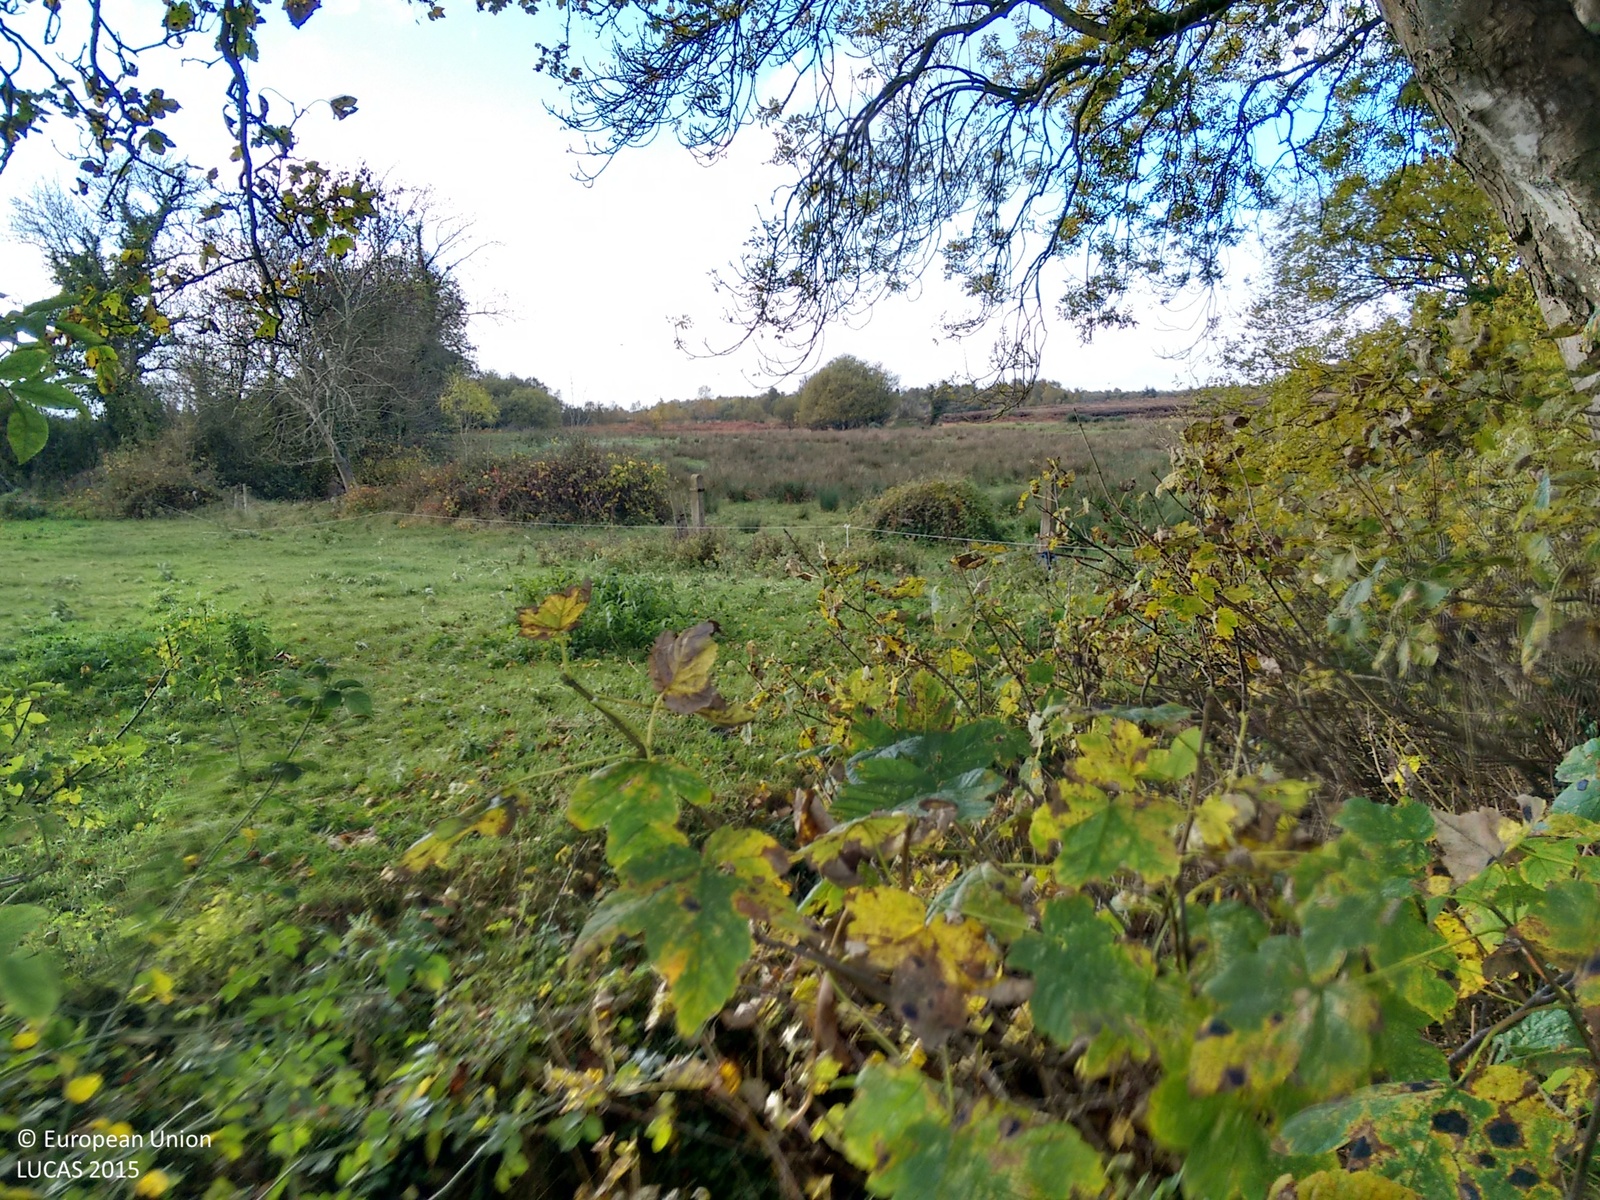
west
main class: Grassland
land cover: Grassland without tree/shrub cover
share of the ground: > 75 %
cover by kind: herbaceous plants 80 %, shrubs 5 %
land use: Agriculture (excluding fallow land and kitchen gardens)
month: October
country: IE
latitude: 53.3116
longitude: -7.6176
